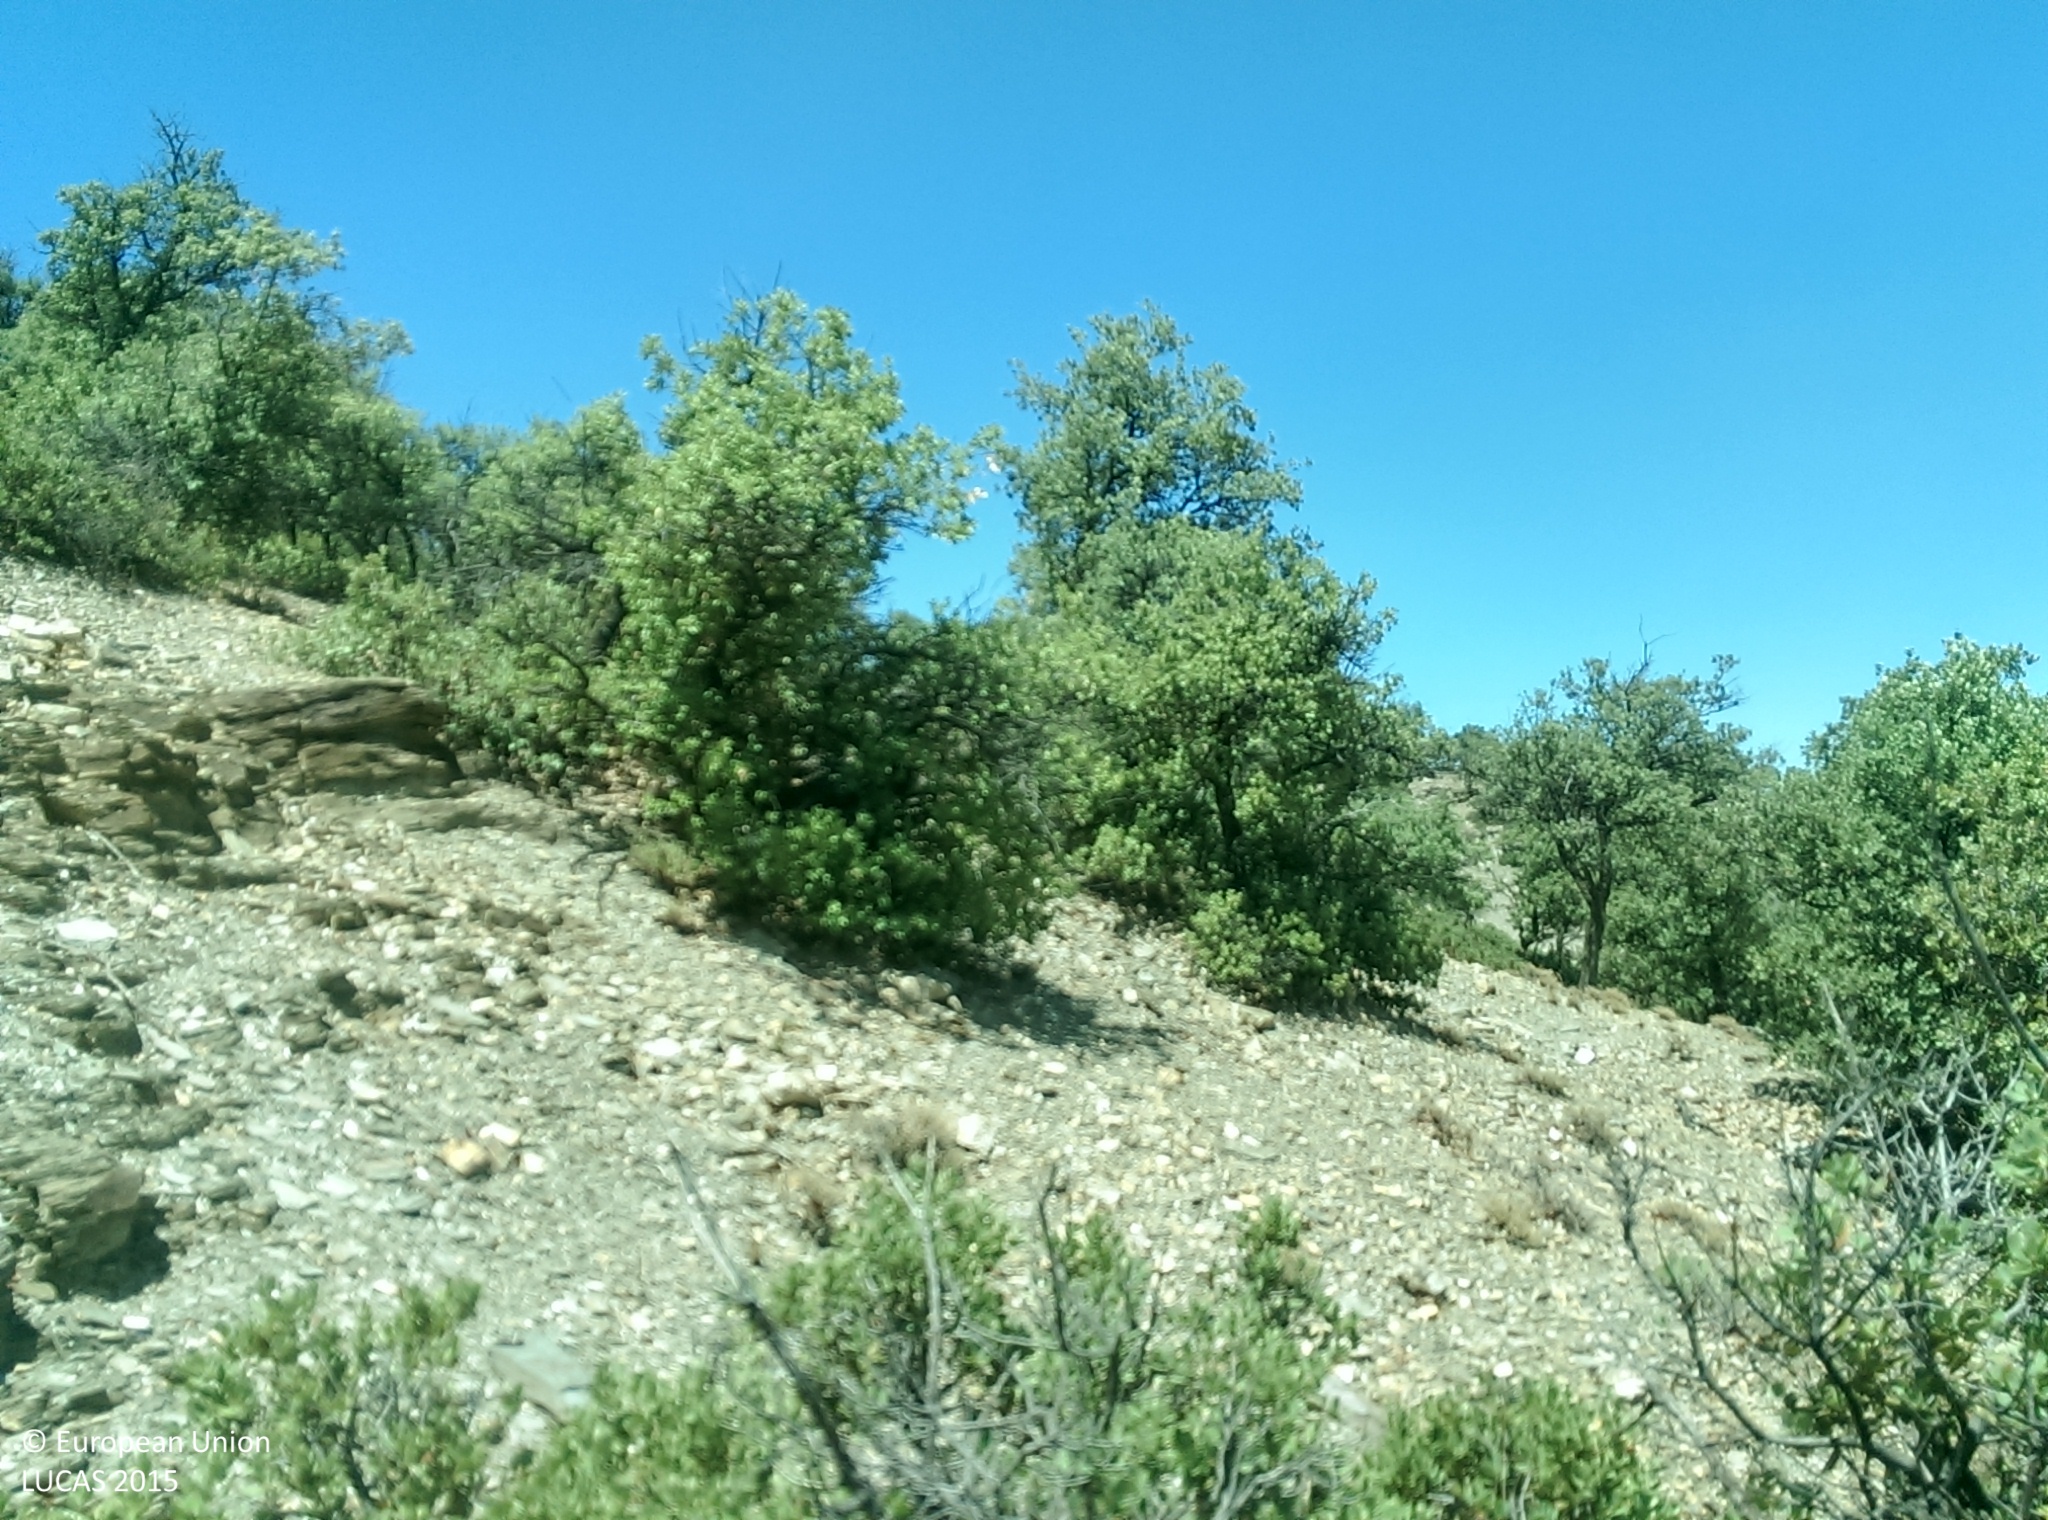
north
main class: Woodland
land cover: Broadleaved woodland
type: broadleaved evergreen forest
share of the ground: 50 - 75 %
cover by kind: broadleaved forest trees 60 %, consolidated bare surface 15 %, shrubs 10 %, unconsolidated bare surface 10 %, herbaceous plants 5 %
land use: Semi-natural and natural areas not in use
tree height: < 5 m
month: July
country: ES
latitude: 37.1519
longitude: -3.0791
